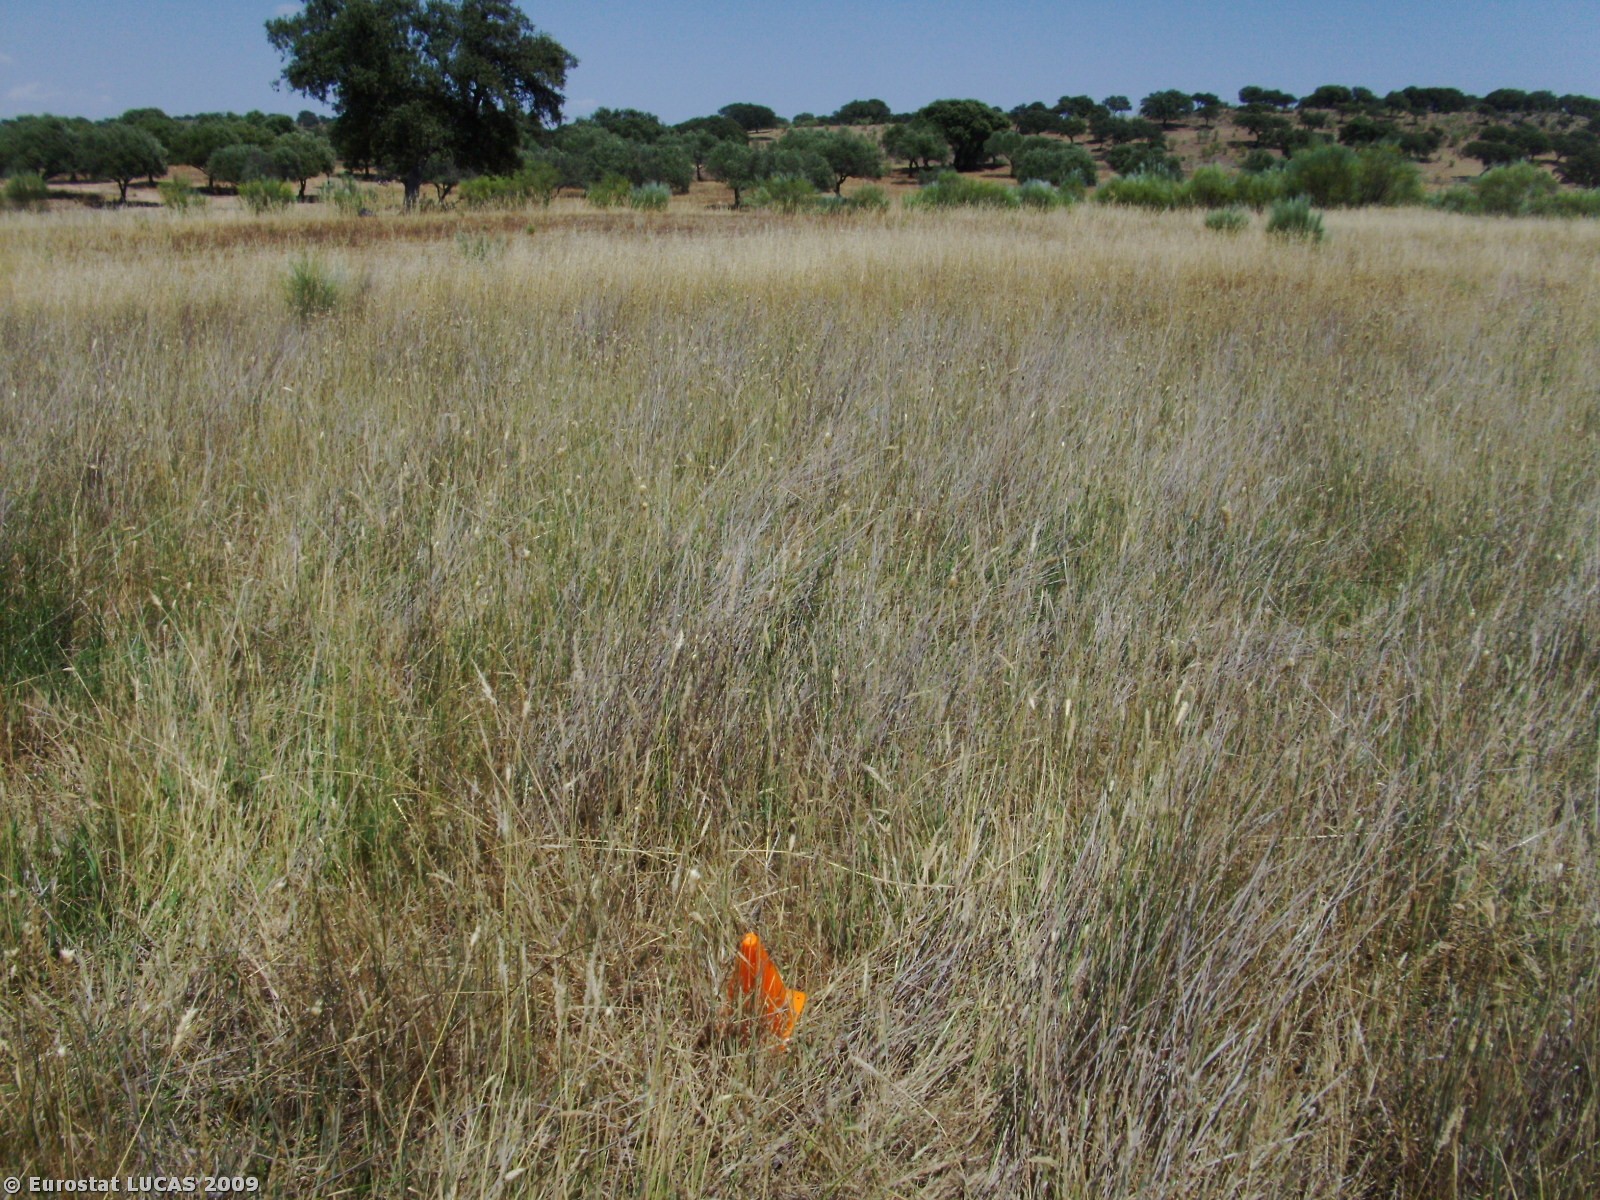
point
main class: Grassland
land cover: Spontaneously vegetated surfaces
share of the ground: > 75 %
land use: Fallow land
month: June
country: PT
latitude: 39.7737
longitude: -7.1708
